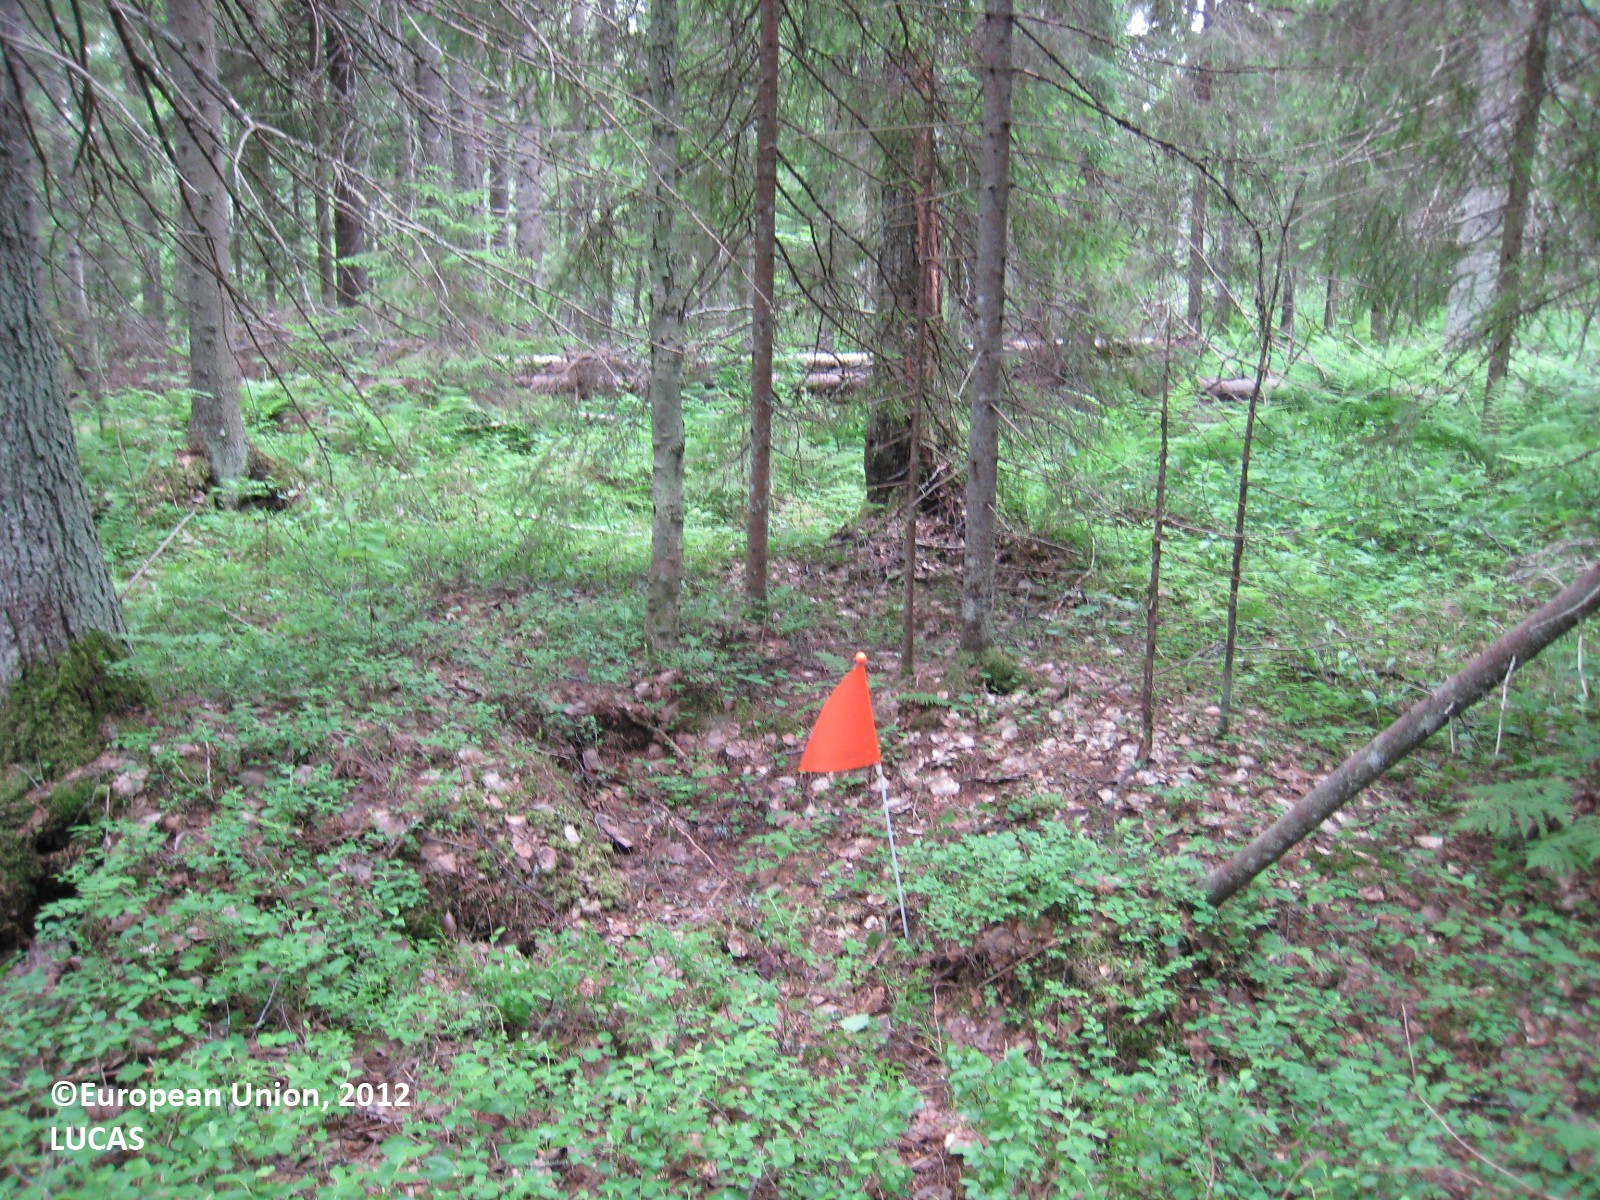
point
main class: Woodland
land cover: Spruce dominated coniferous woodland
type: boreal forest
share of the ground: 50 - 75 %
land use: Forestry
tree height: > 5 m
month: June
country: FI
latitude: 62.0653
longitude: 26.3055
